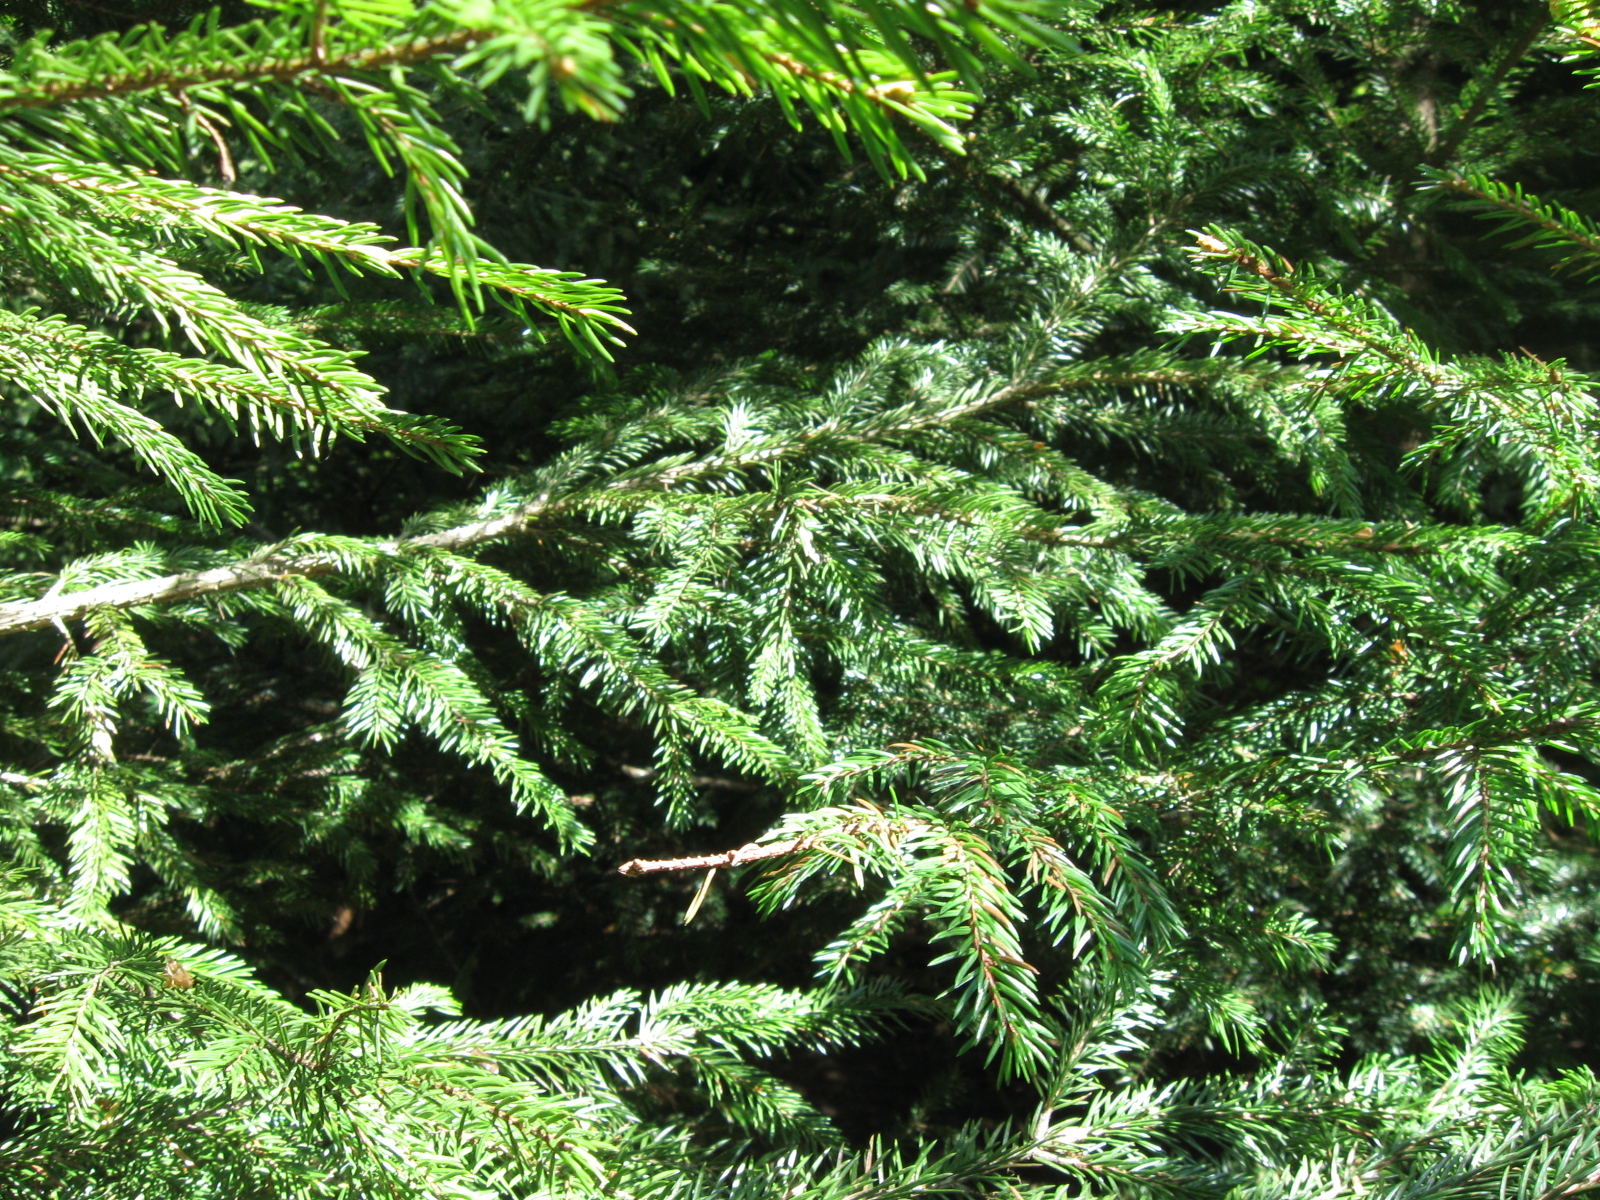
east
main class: Woodland
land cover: Spruce dominated mixed woodland
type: hemiboreal forest and nemoral coniferous forest and mixed broadleaved-coniferous forest
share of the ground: > 75 %
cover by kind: coniferous forest trees 75 %, broadleaved forest trees 25 %
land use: Forestry
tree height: > 5 m
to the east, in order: Spruce dominated mixed woodland; Broadleaved woodland; Pine dominated mixed woodland; Other mixed woodland
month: May
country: LT
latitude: 54.2690
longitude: 23.2990
